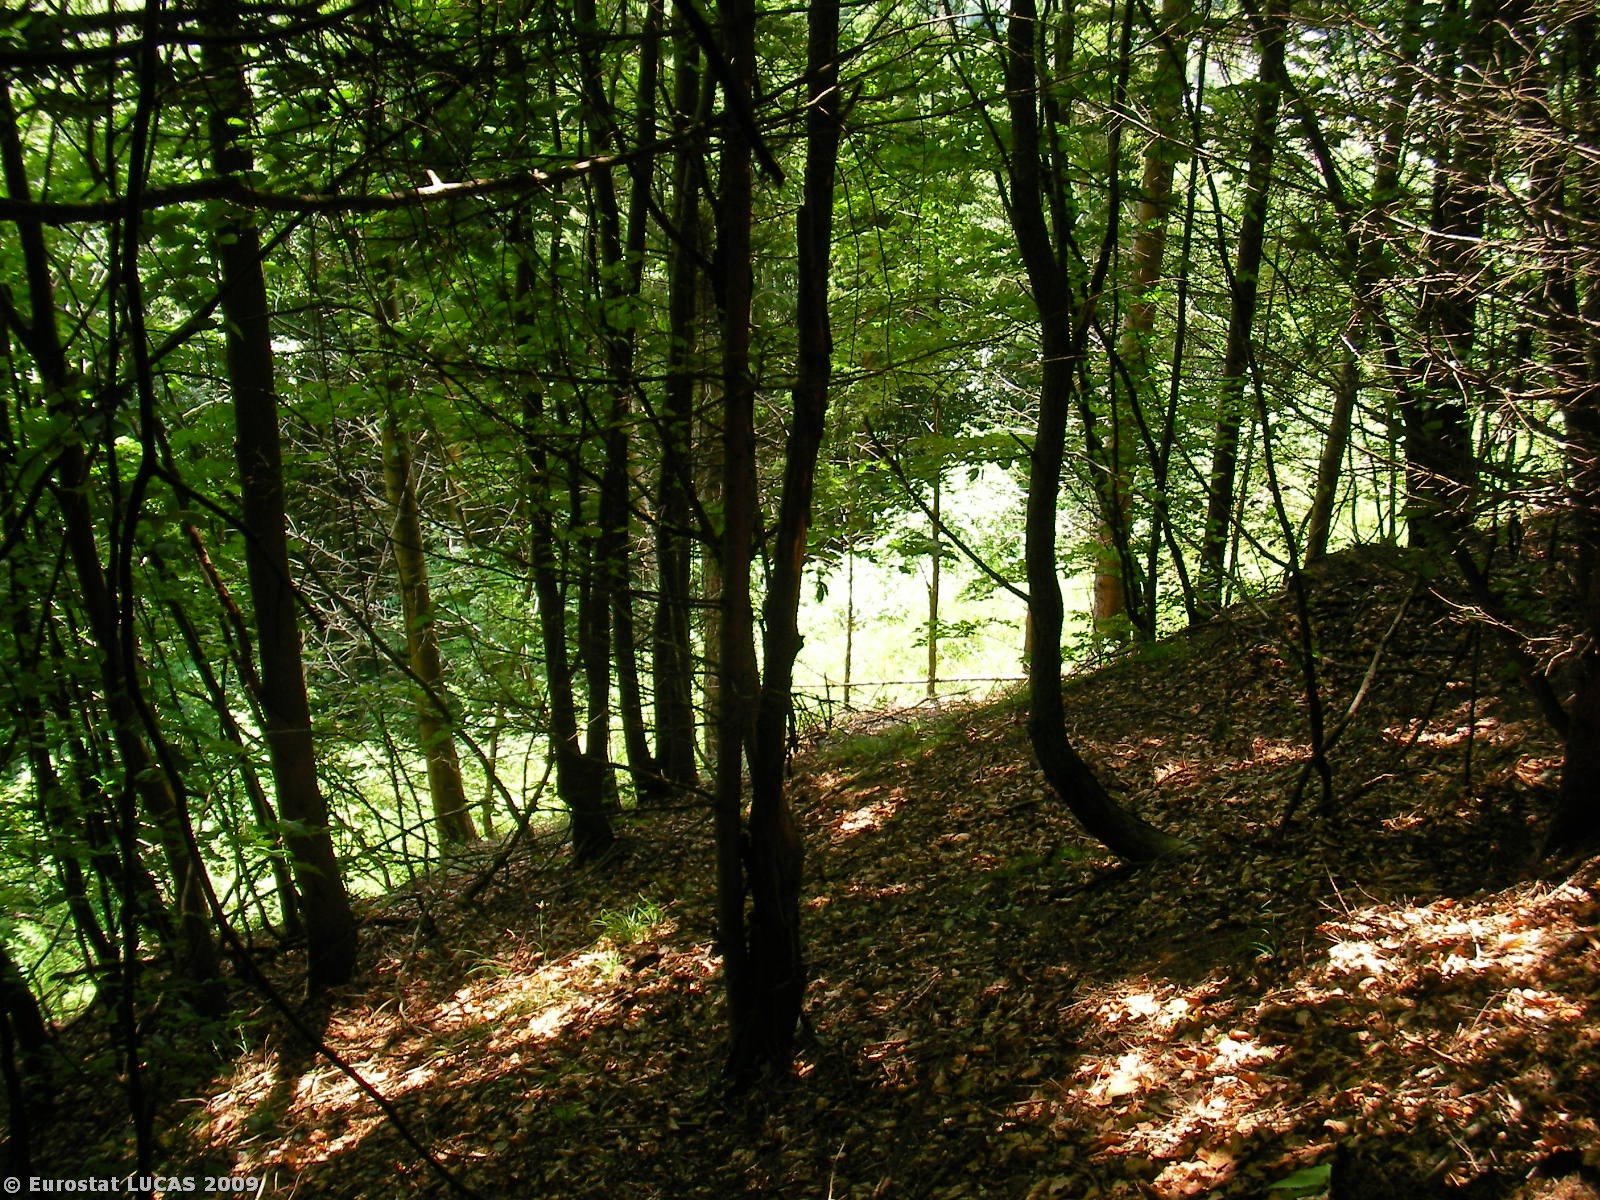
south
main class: Woodland
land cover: Mixed woodland
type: hemiboreal forest and nemoral coniferous forest and mixed broadleaved-coniferous forest
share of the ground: > 75 %
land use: Forestry
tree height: > 5 m
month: June
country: AT
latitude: 47.3728
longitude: 15.3374
